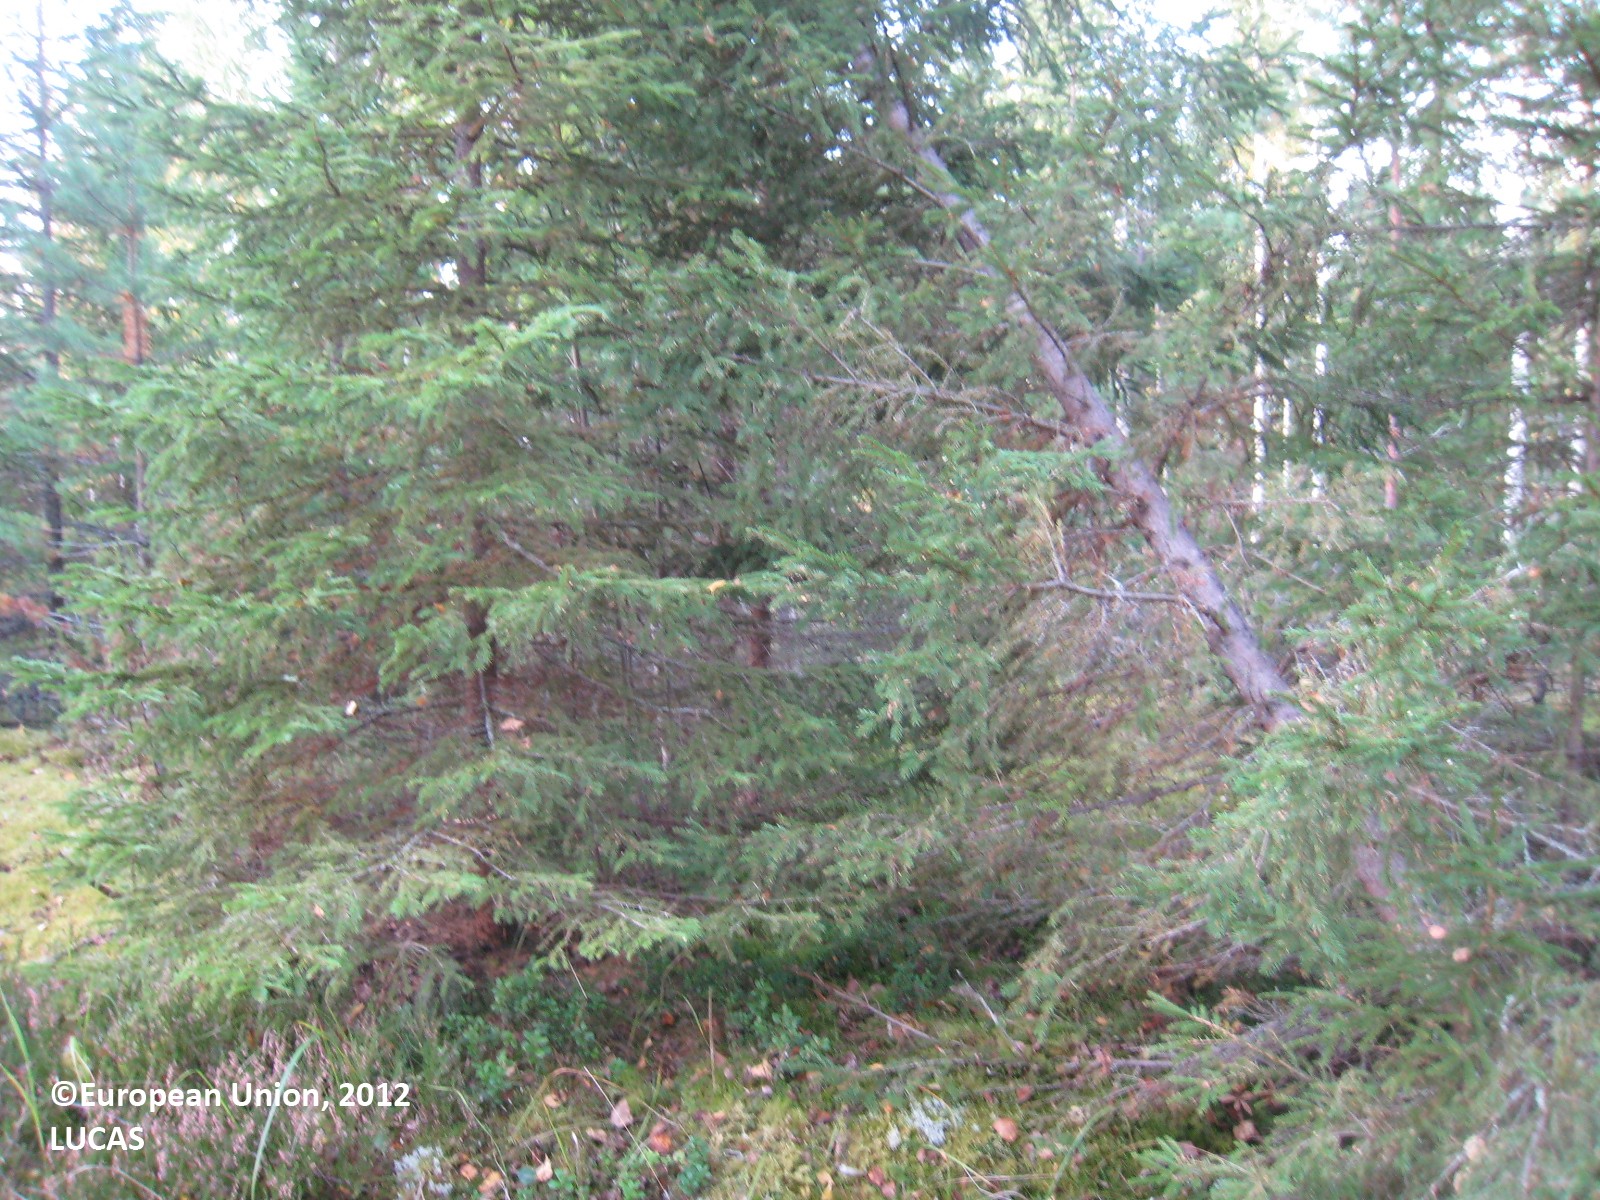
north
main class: Woodland
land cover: Spruce dominated mixed woodland
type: boreal forest
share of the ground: 50 - 75 %
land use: Forestry
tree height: > 5 m
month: September
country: FI
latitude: 62.6403
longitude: 26.4600
